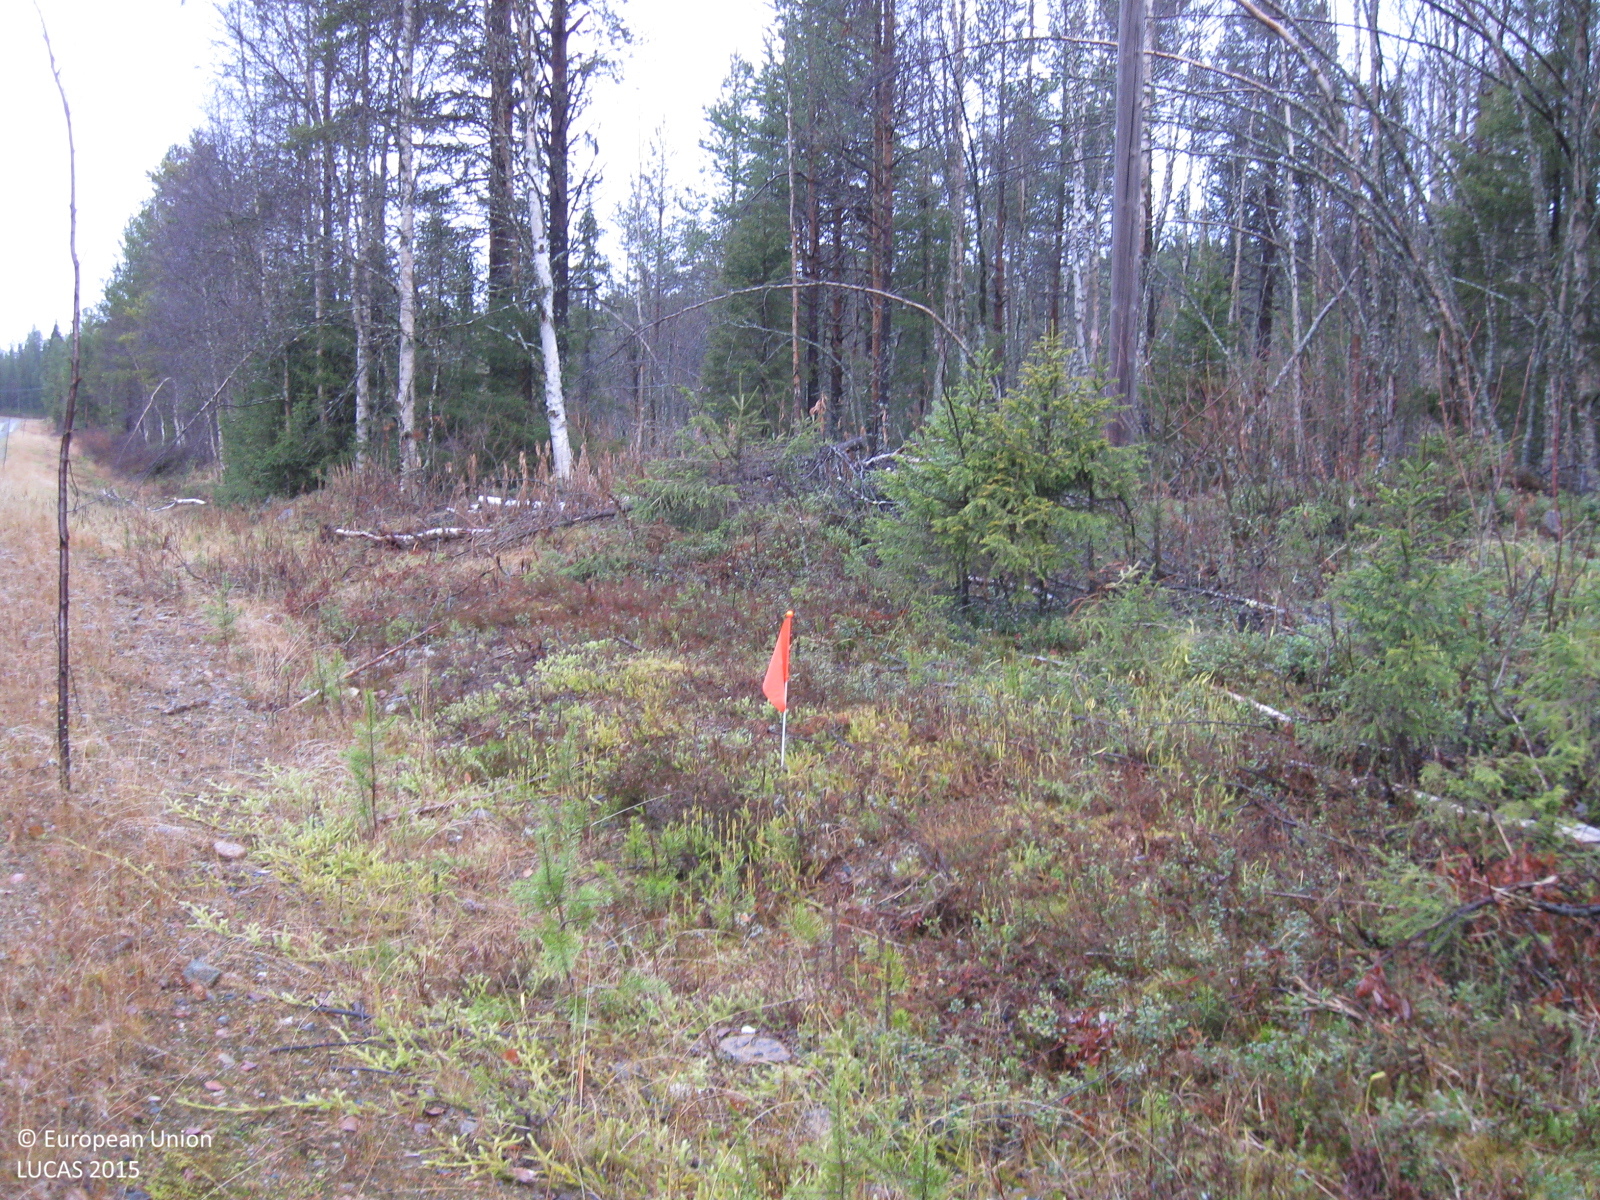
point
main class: Woodland
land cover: Spruce dominated mixed woodland
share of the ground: 25 - 50 %
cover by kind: shrubs 30 %, coniferous forest trees 25 %, broadleaved forest trees 20 %, herbaceous plants 10 %, lichens and mosses 10 %, unconsolidated bare surface 5 %
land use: Road transport
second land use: Forestry
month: October
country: SE
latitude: 66.7755
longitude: 21.0230
